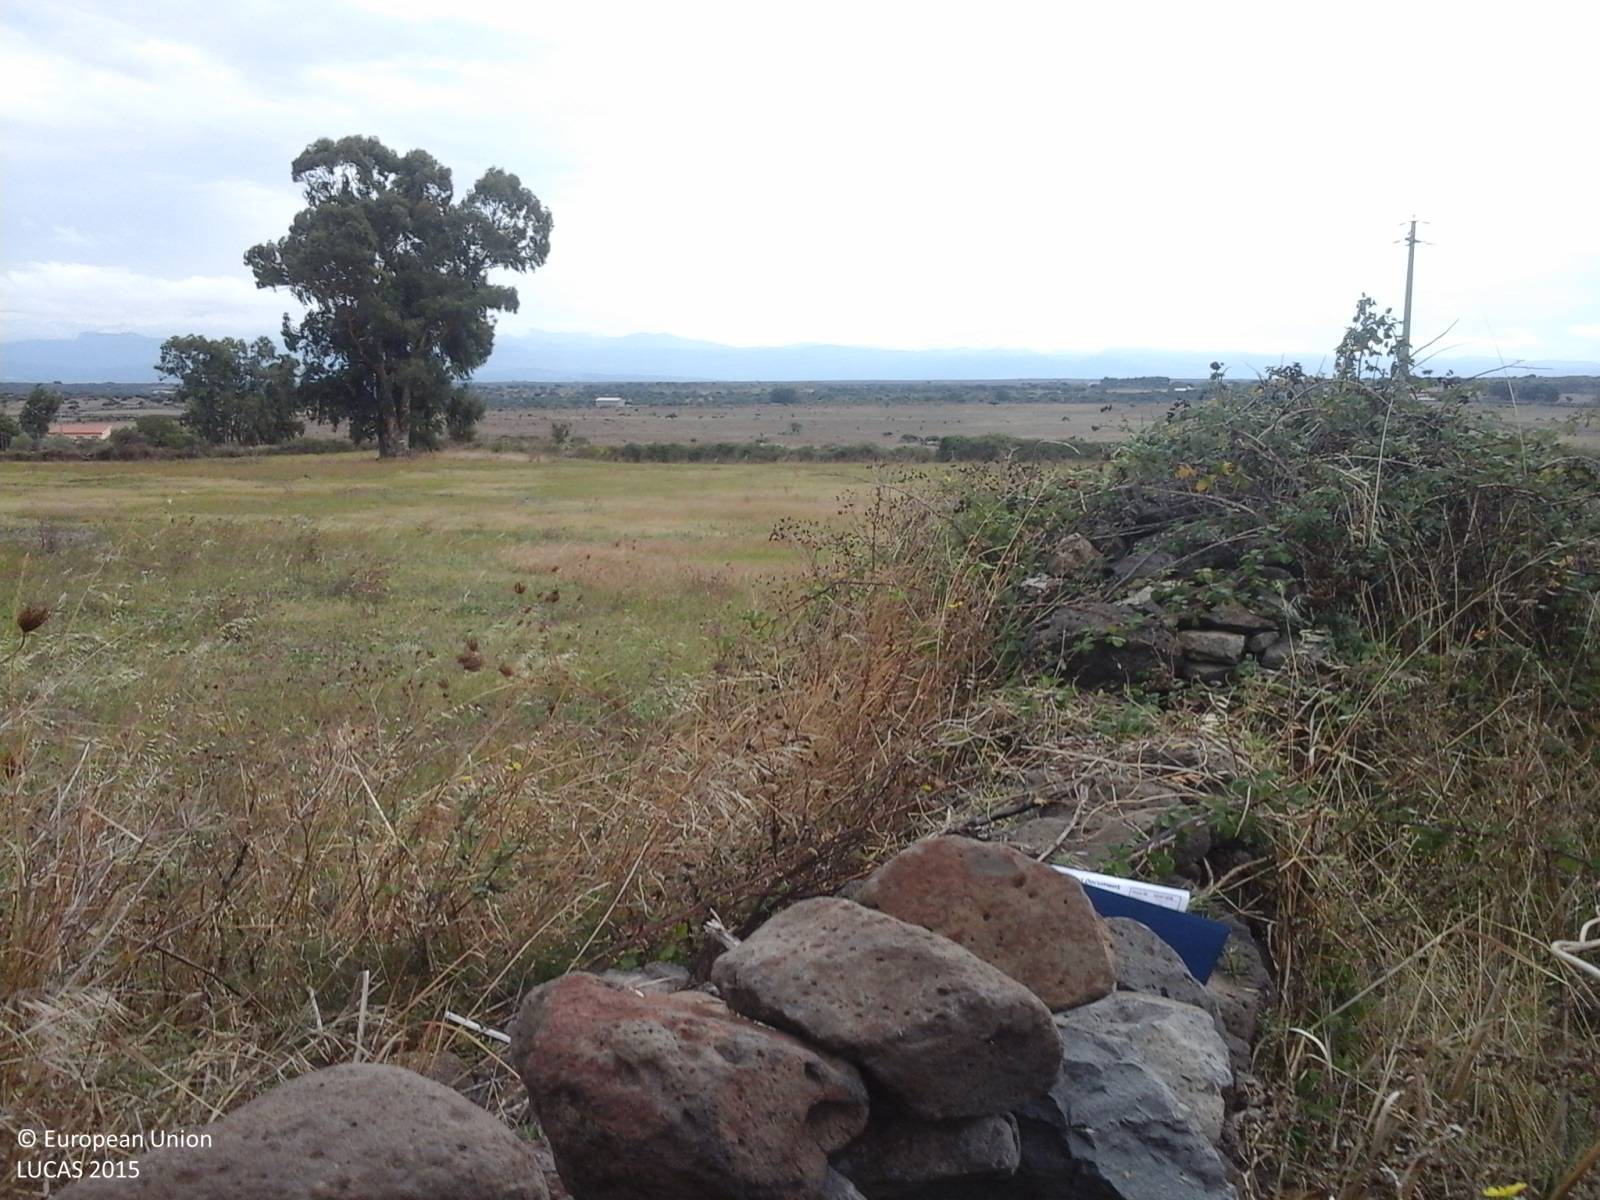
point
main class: Grassland
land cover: Grassland without tree/shrub cover
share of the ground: > 75 %
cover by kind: herbaceous plants 100 %
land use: Agriculture (excluding fallow land and kitchen gardens)
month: September
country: IT
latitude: 40.2602
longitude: 8.8186
